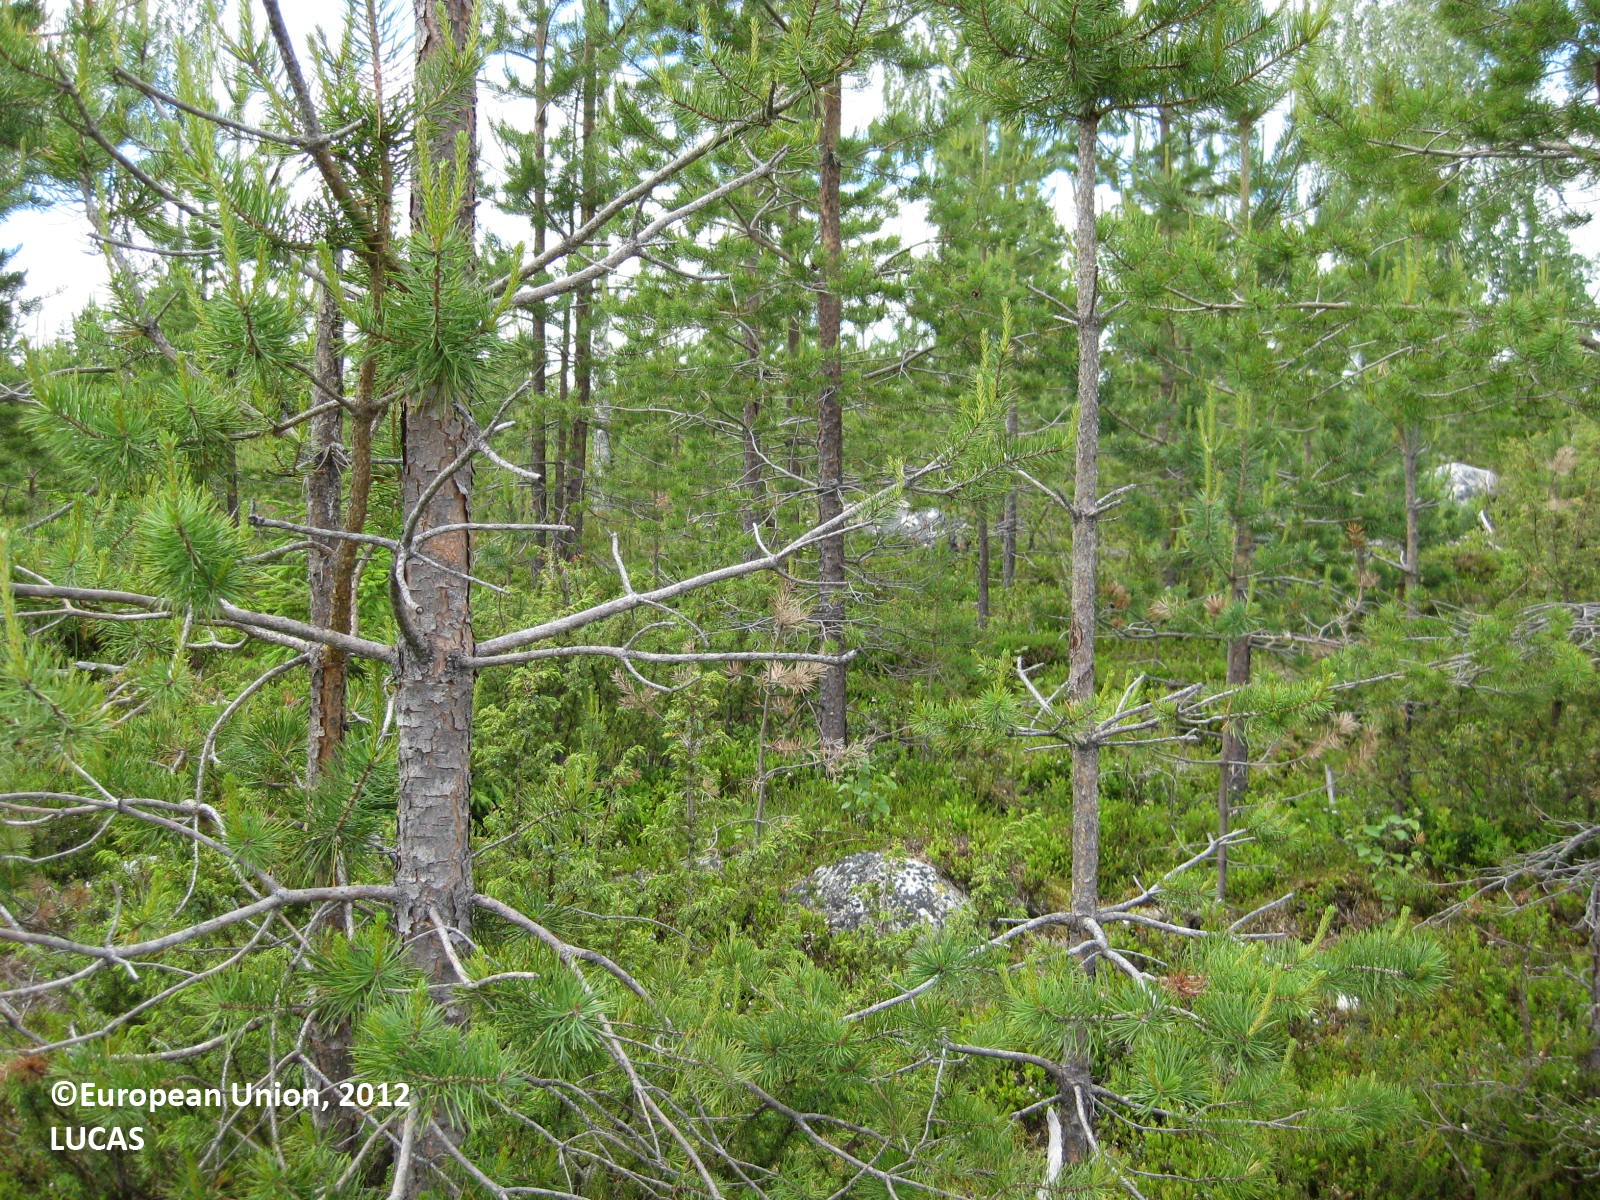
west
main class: Woodland
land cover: Pine dominated coniferous woodland
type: boreal forest
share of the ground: 50 - 75 %
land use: Forestry
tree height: > 5 m
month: July
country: FI
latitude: 65.4805
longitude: 29.3027
